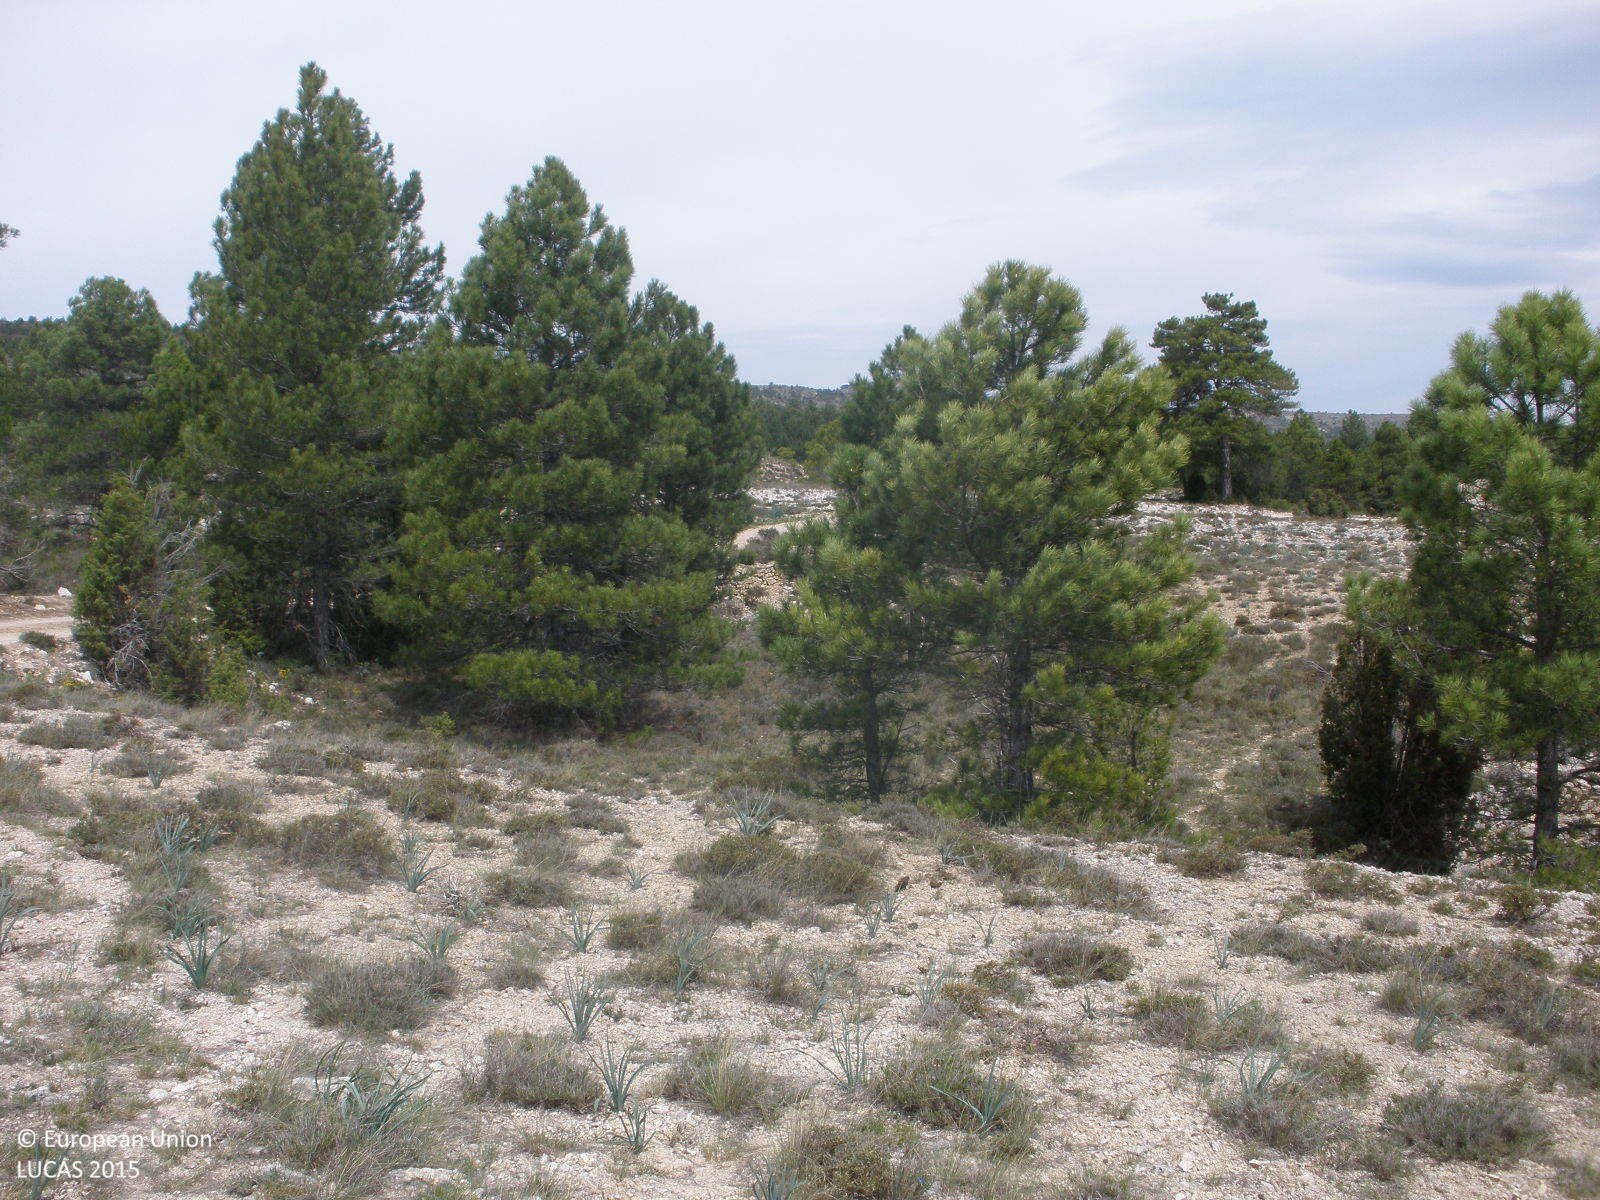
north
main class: Shrubland
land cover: Shrubland without tree cover
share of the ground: 25 - 50 %
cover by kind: herbaceous plants 40 %, shrubs 30 %, consolidated bare surface 30 %
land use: Semi-natural and natural areas not in use
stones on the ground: > 50 %
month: May
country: ES
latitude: 40.6197
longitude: -0.6134
